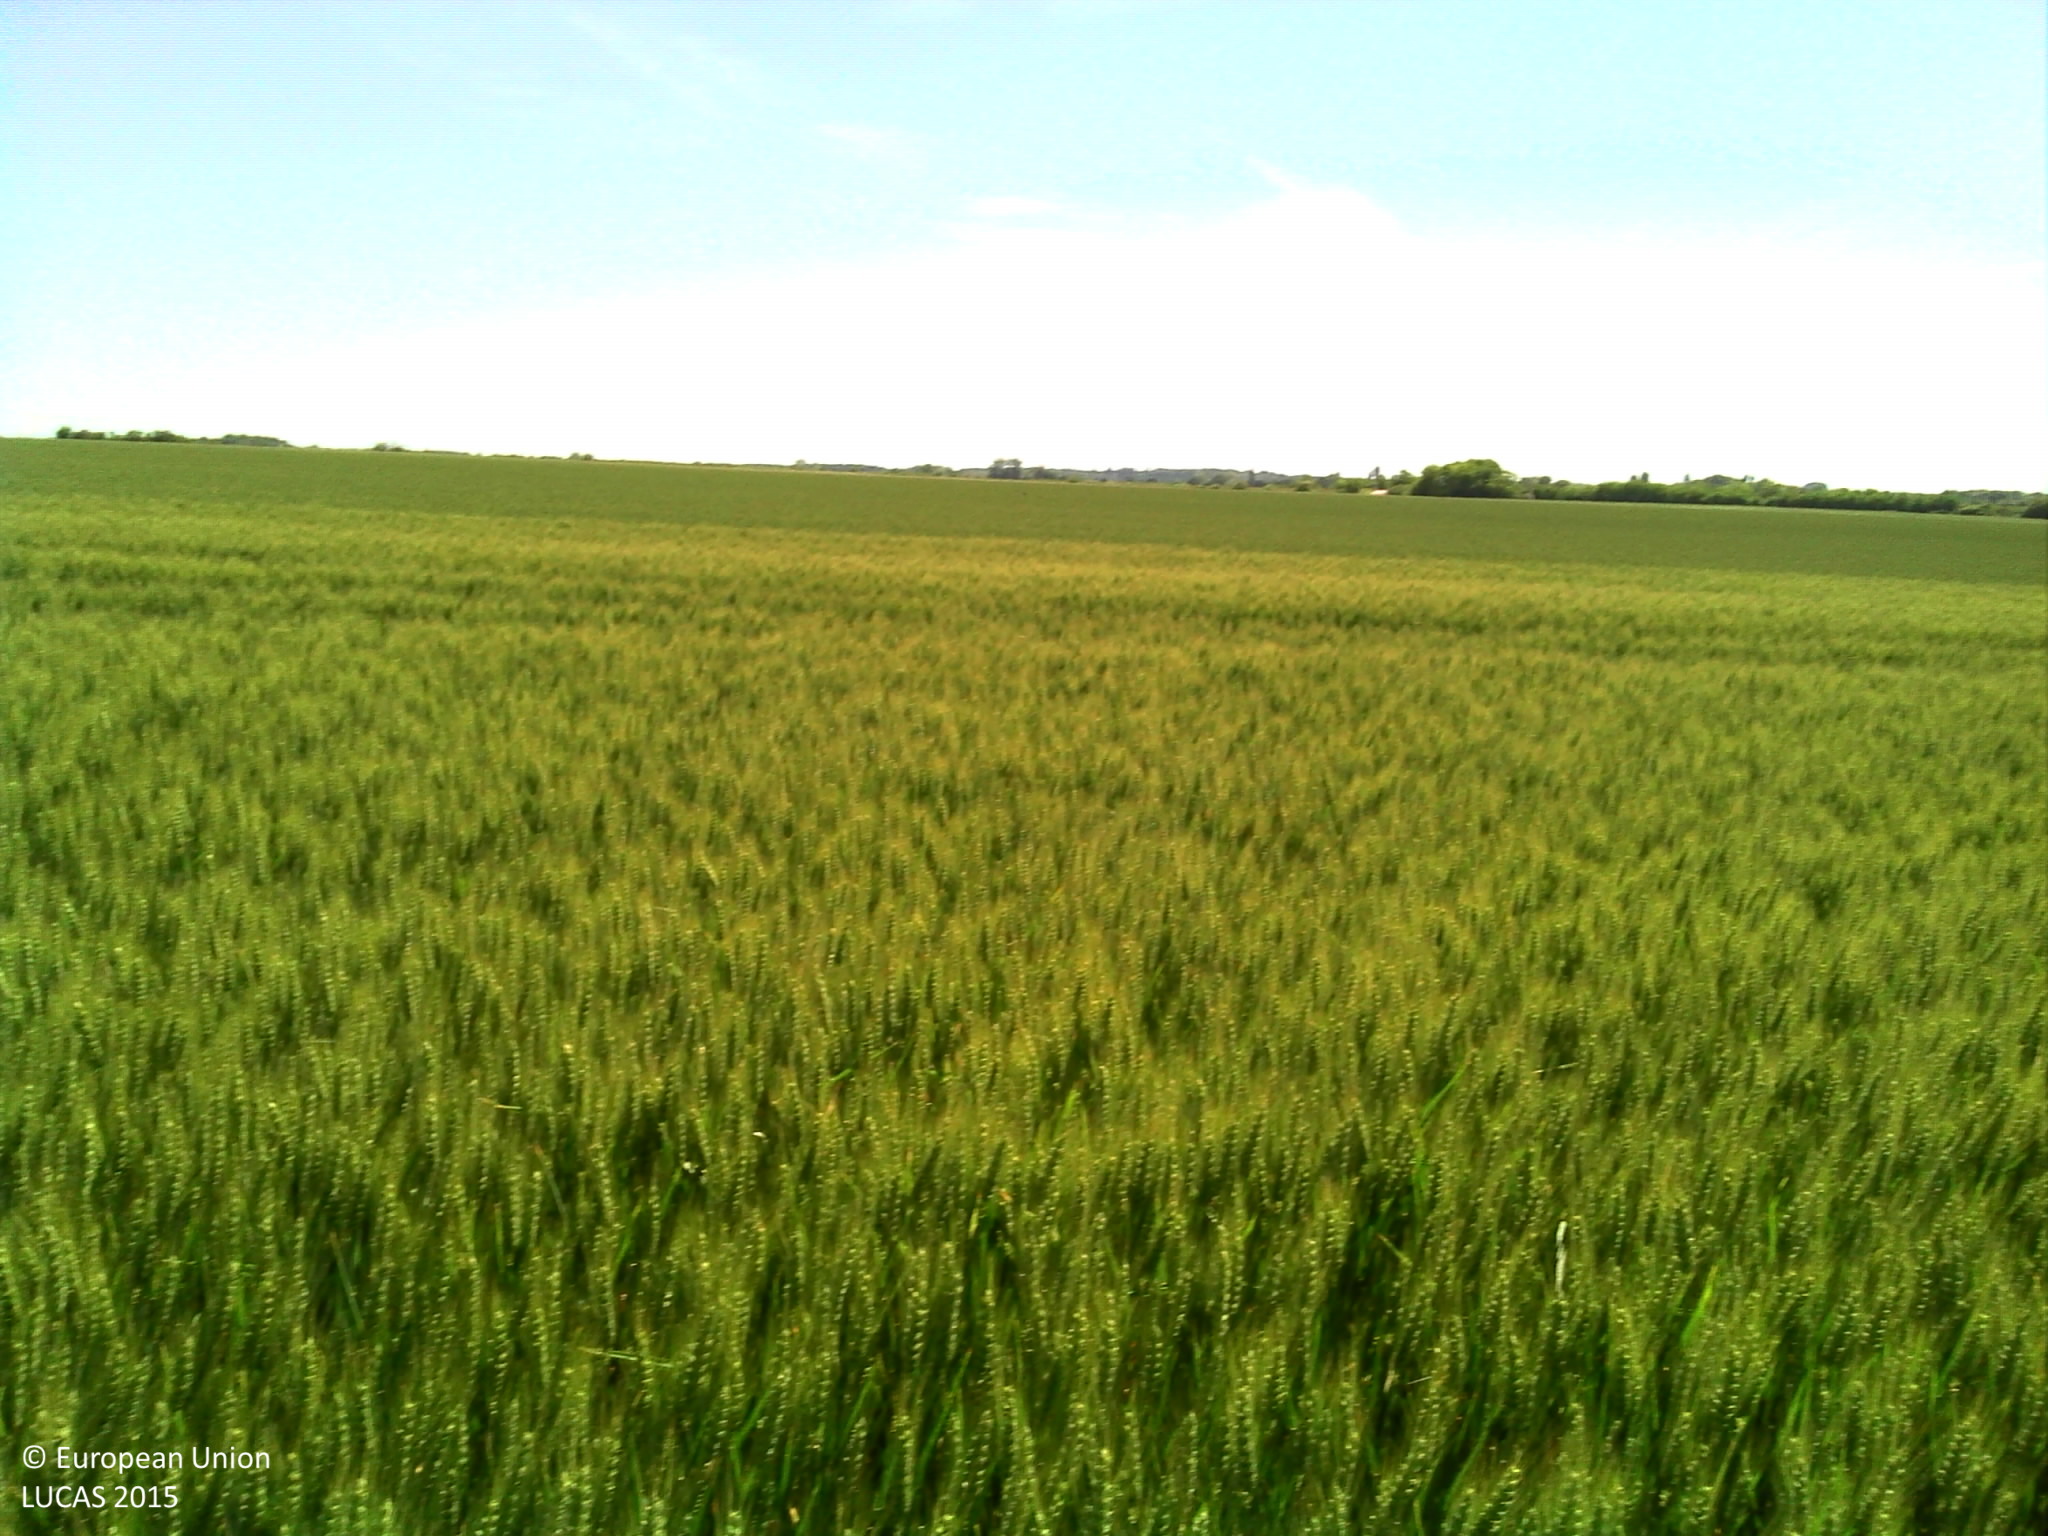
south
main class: Cropland
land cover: Common wheat
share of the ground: > 75 %
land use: Agriculture (excluding fallow land and kitchen gardens)
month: June
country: FR
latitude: 47.0249
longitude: 2.7184
